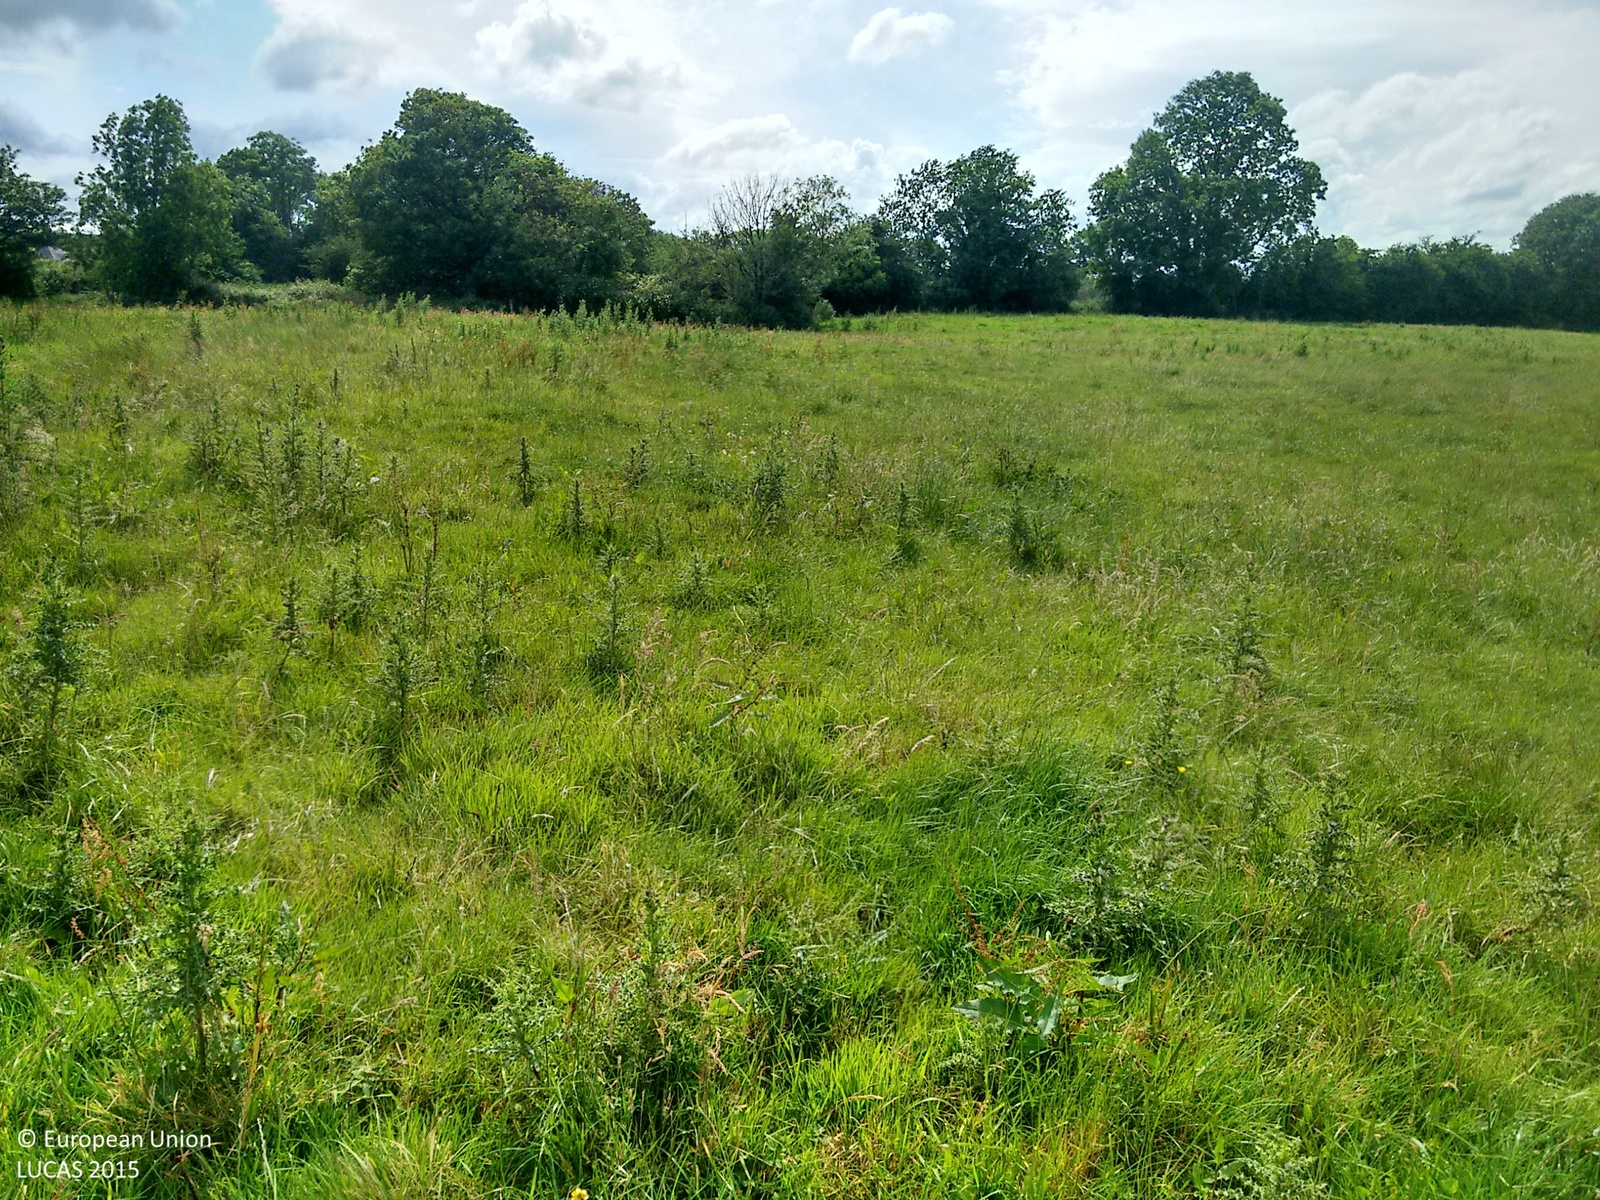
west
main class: Grassland
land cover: Grassland without tree/shrub cover
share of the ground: > 75 %
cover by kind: herbaceous plants 100 %
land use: Agriculture (excluding fallow land and kitchen gardens)
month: July
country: IE
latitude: 52.1340
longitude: -8.8946
